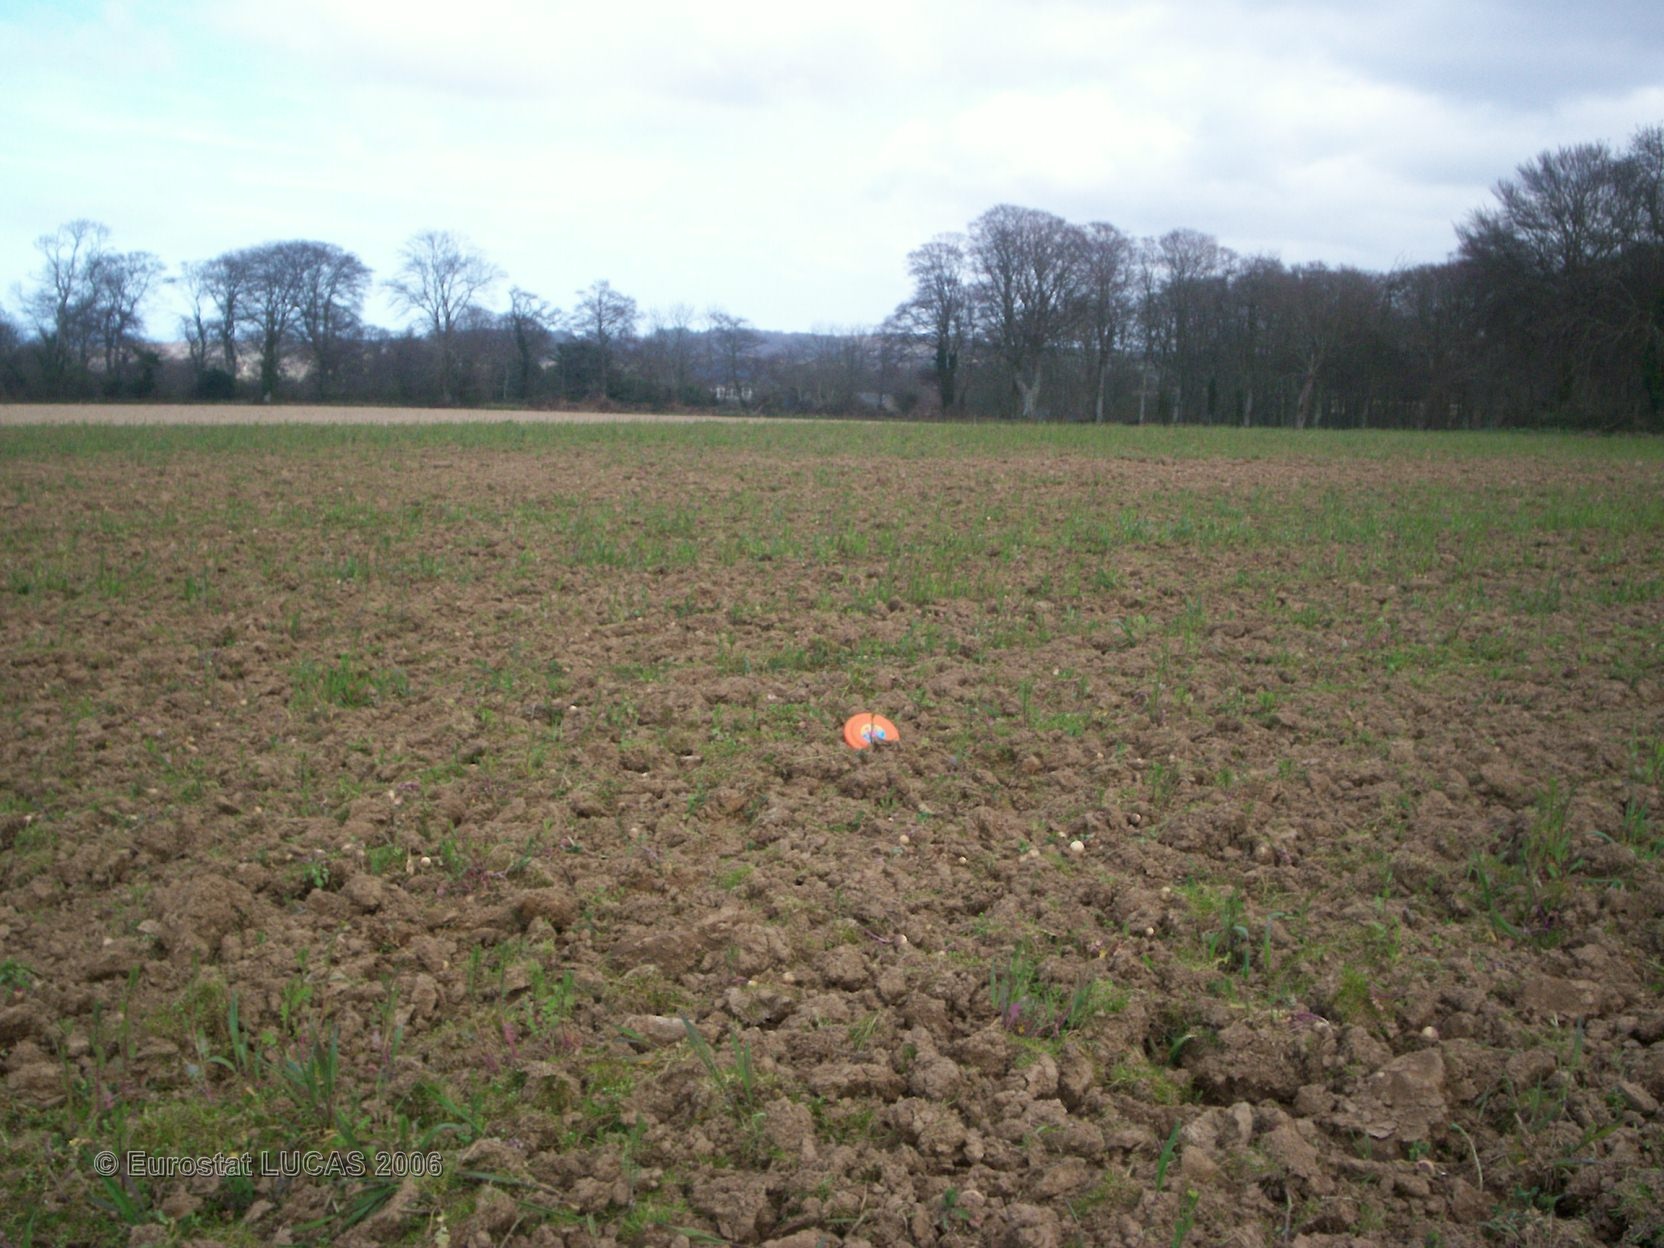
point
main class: Cropland
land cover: Maize
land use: Agriculture (excluding fallow land and kitchen gardens)
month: May
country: FR
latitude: 49.6597
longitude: -1.4502
